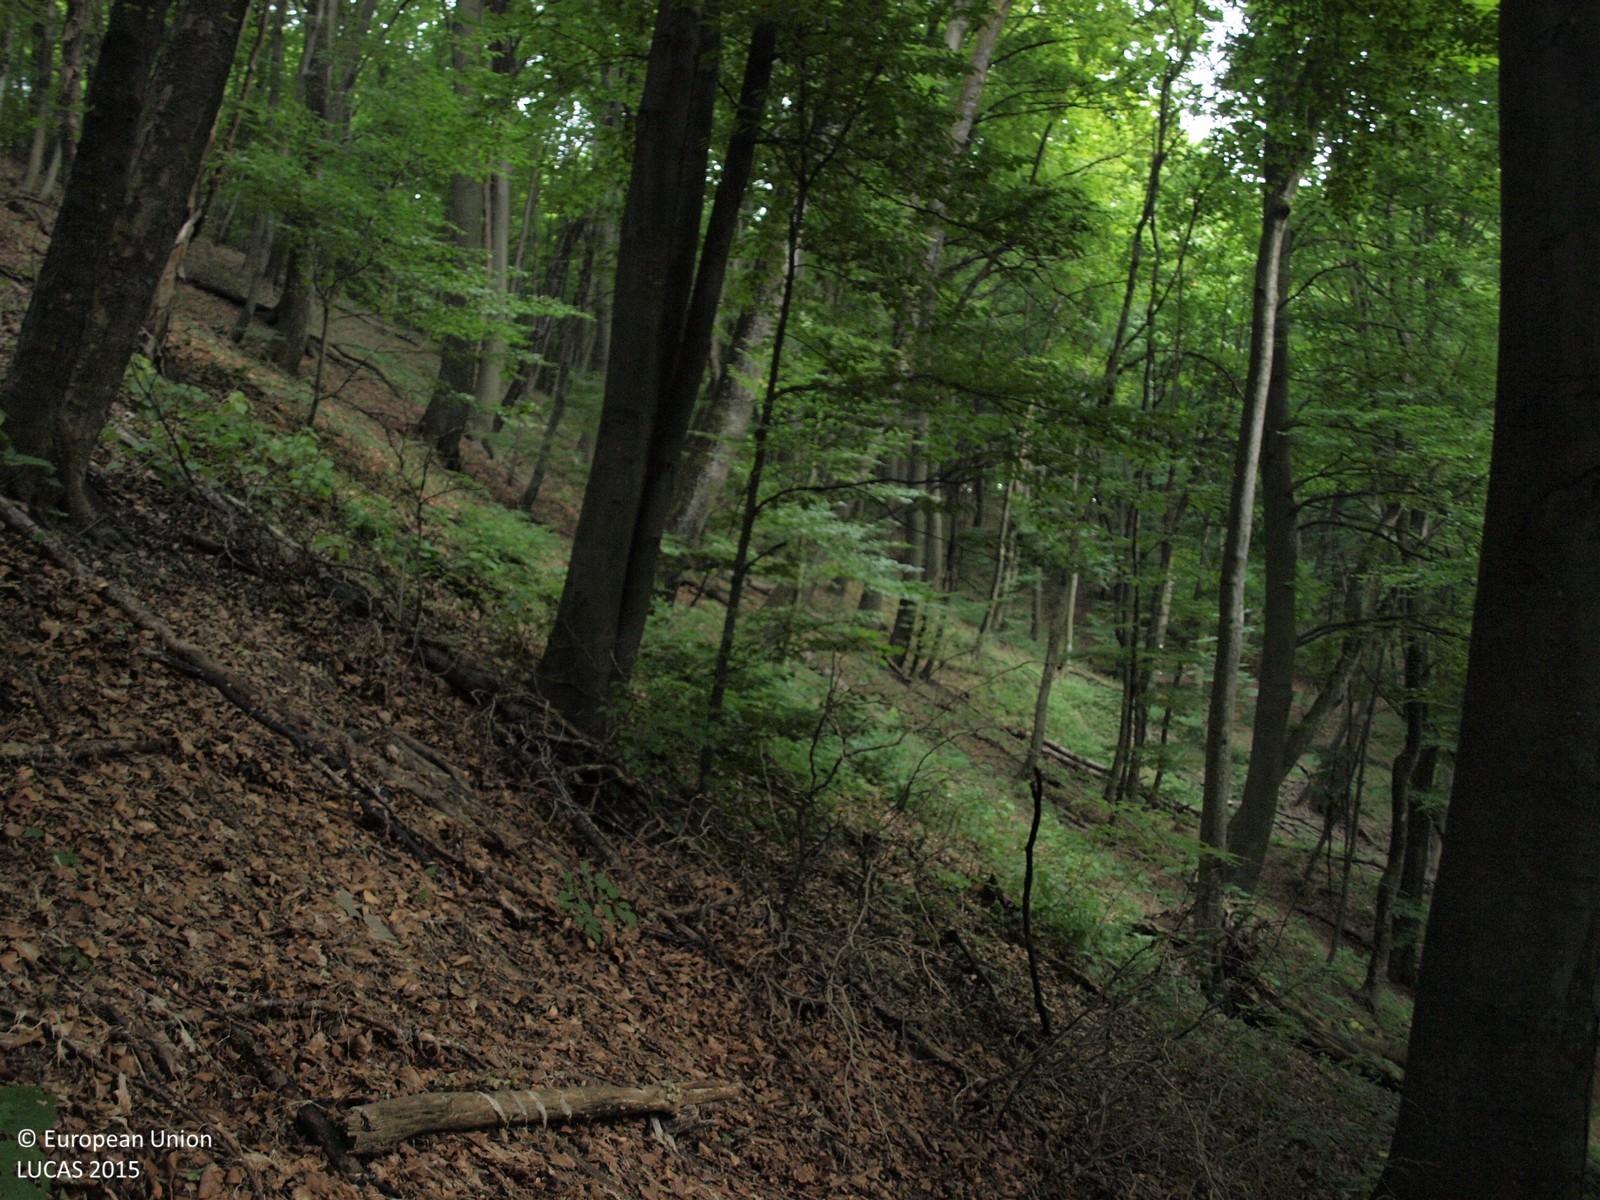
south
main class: Woodland
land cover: Broadleaved woodland
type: beech forest
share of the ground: > 75 %
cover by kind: broadleaved forest trees 90 %, shrubs 5 %, herbaceous plants 5 %
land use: Forestry
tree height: > 5 m
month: July
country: HR
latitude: 46.2033
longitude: 16.5712
